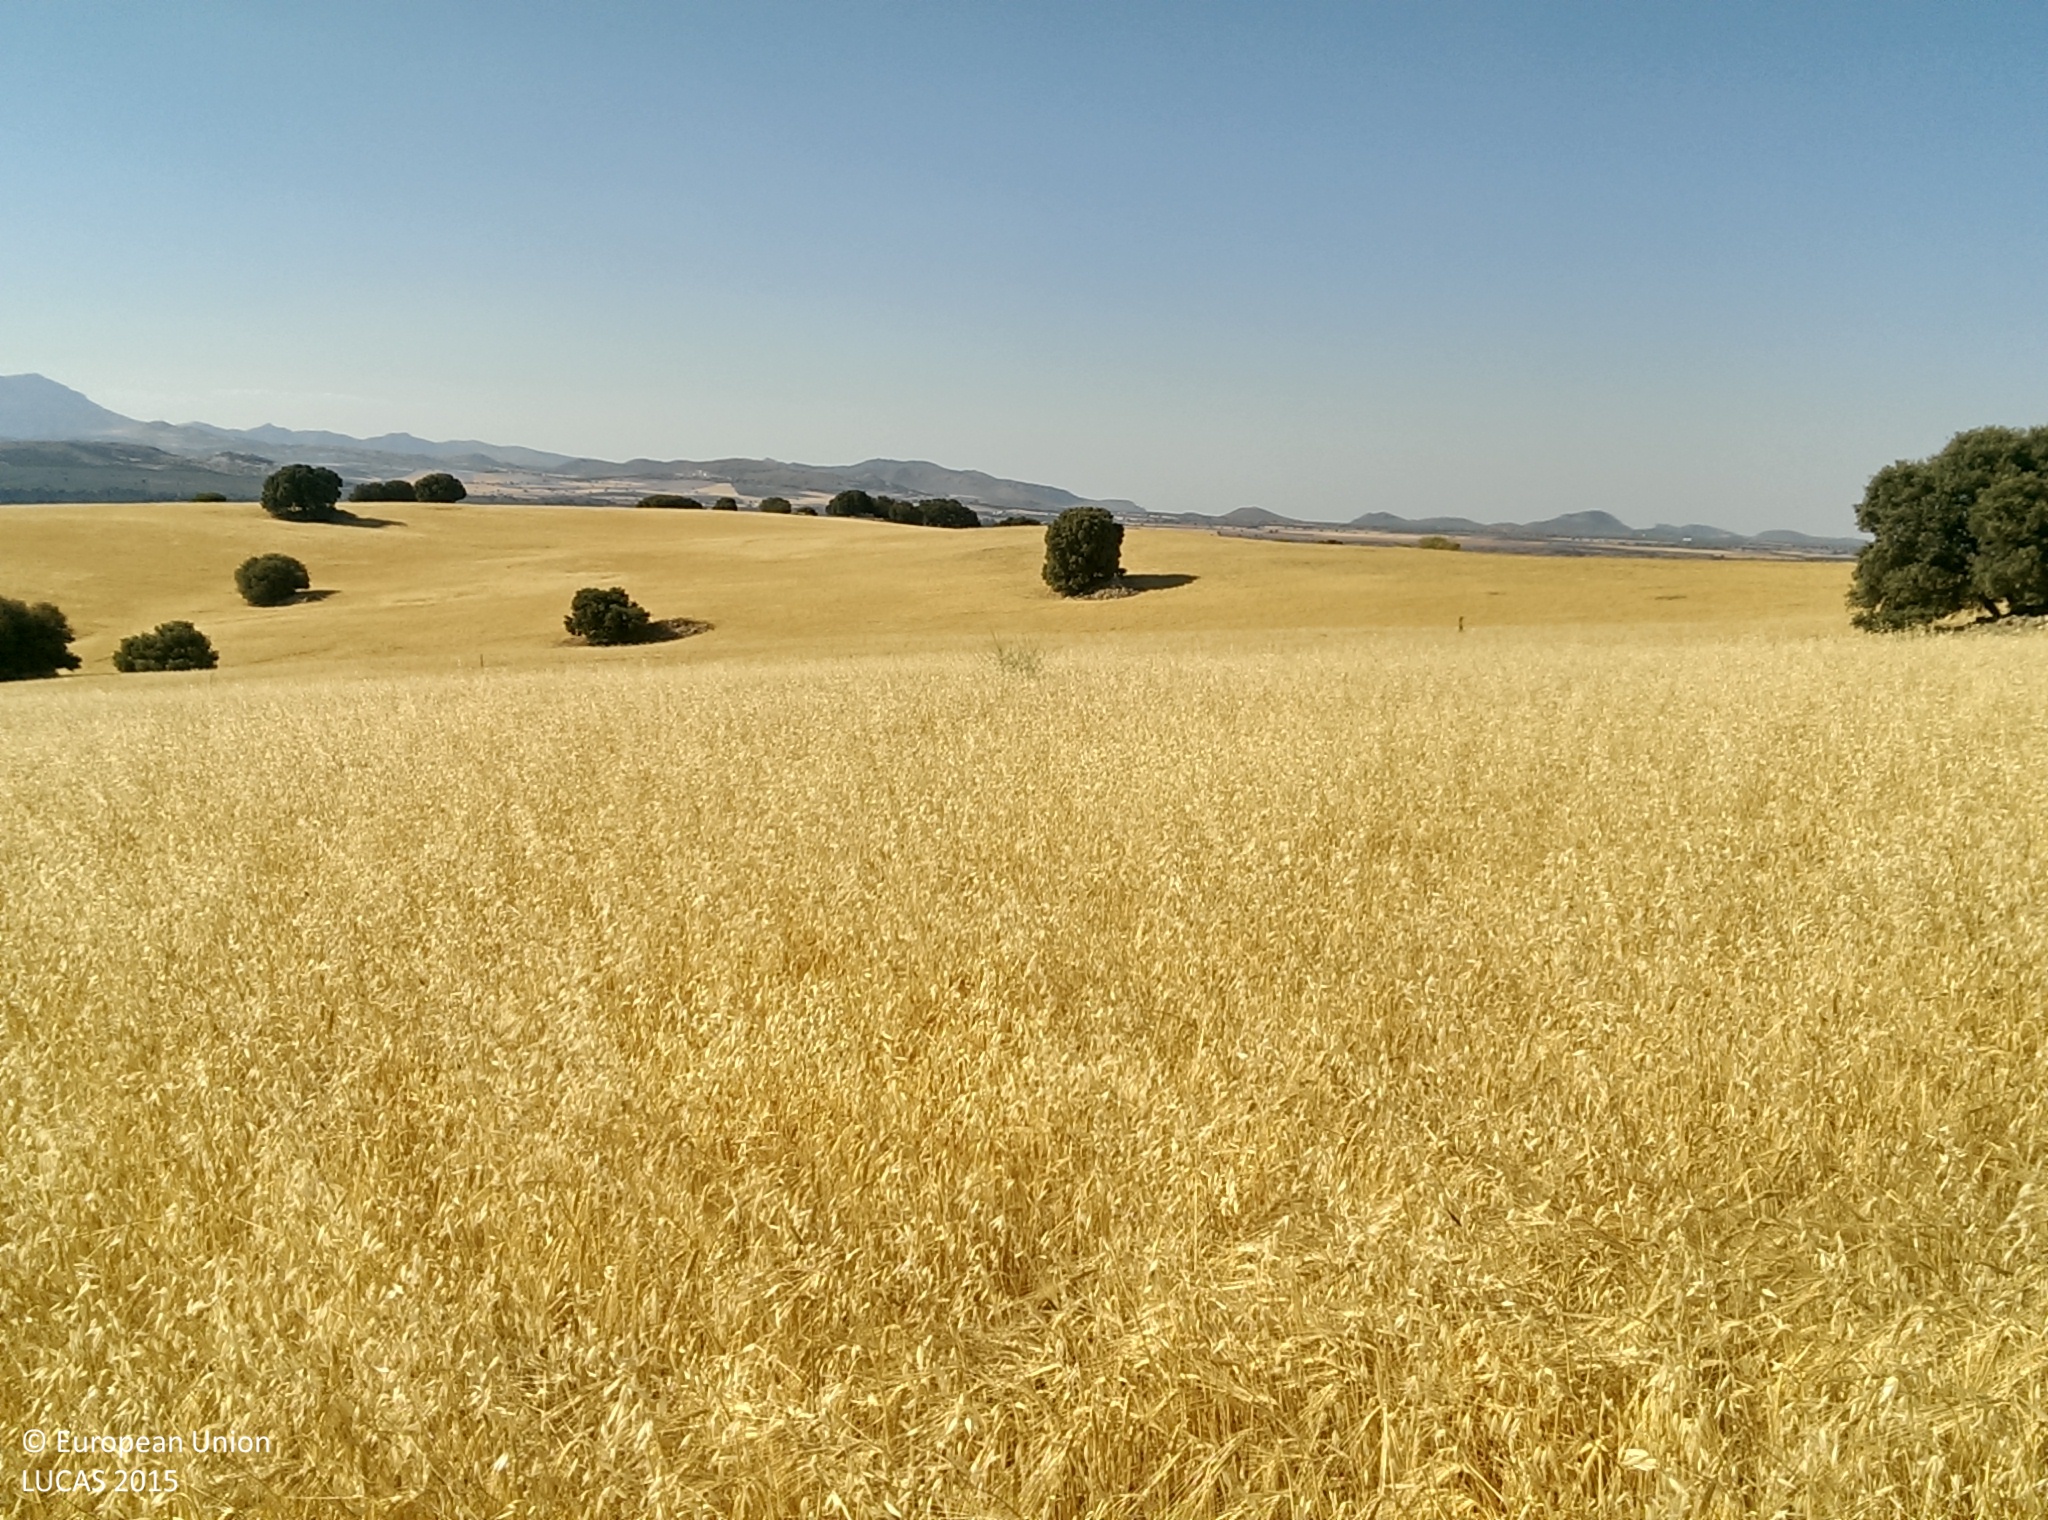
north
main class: Cropland
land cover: Barley
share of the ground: > 75 %
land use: Agriculture (excluding fallow land and kitchen gardens)
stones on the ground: < 10 %
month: June
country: ES
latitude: 37.5441
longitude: -3.2911
